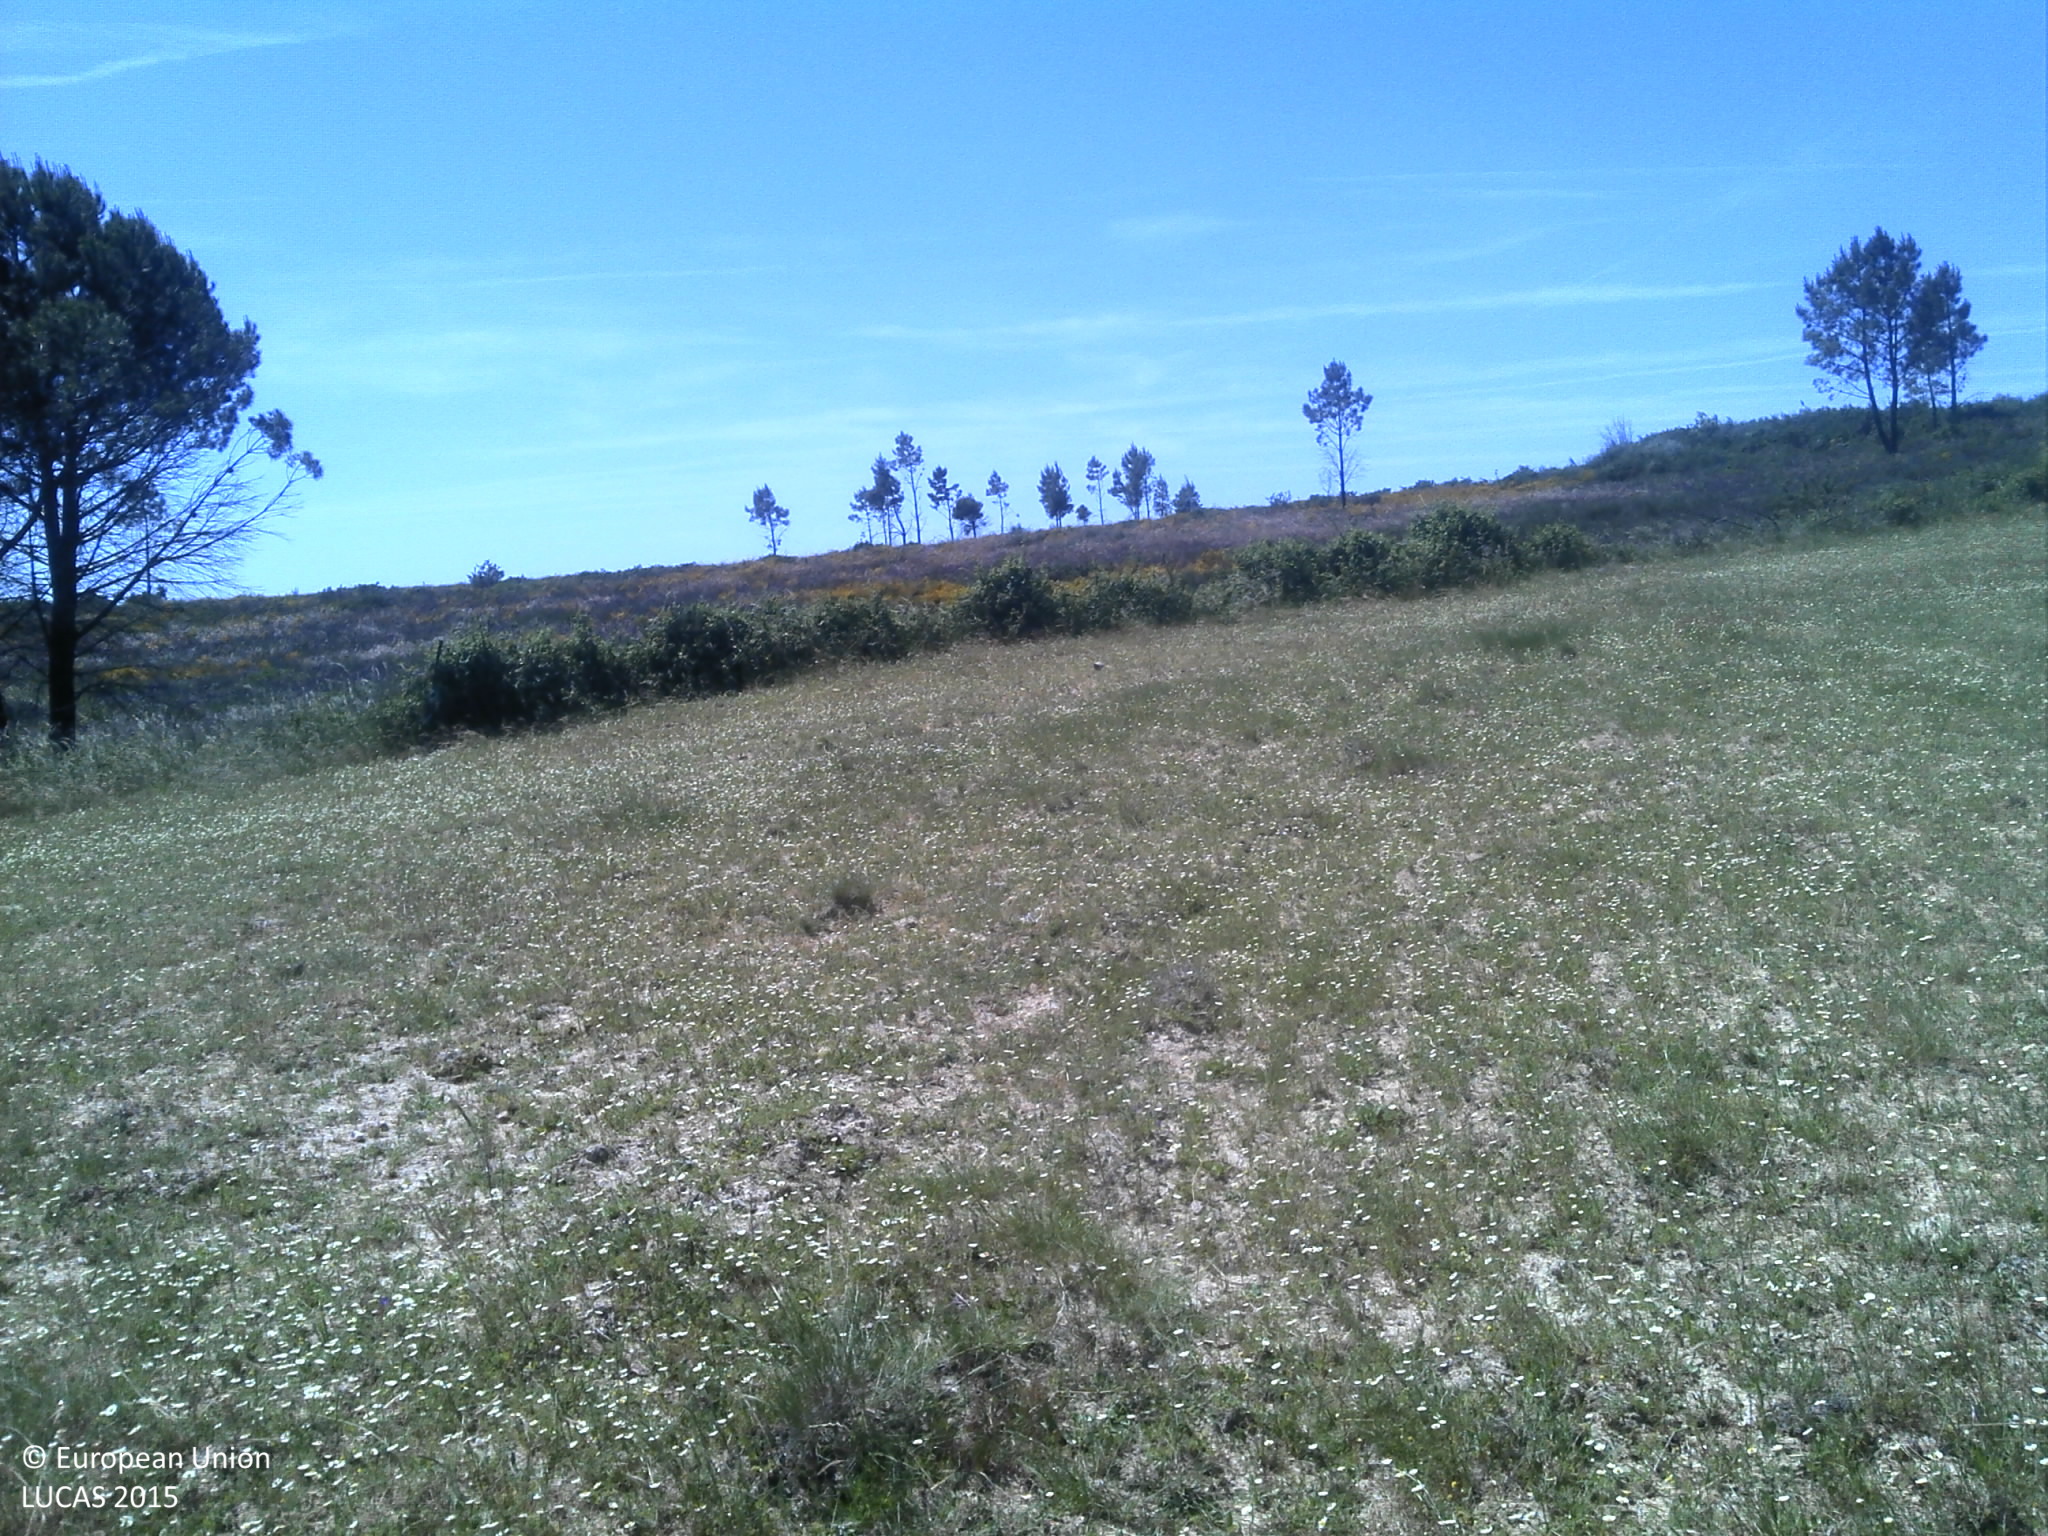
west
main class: Grassland
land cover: Grassland without tree/shrub cover
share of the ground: 25 - 50 %
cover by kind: herbaceous plants 50 %, unconsolidated bare surface 50 %
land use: Agriculture (excluding fallow land and kitchen gardens)
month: May
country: PT
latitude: 40.4845
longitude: -7.7296
